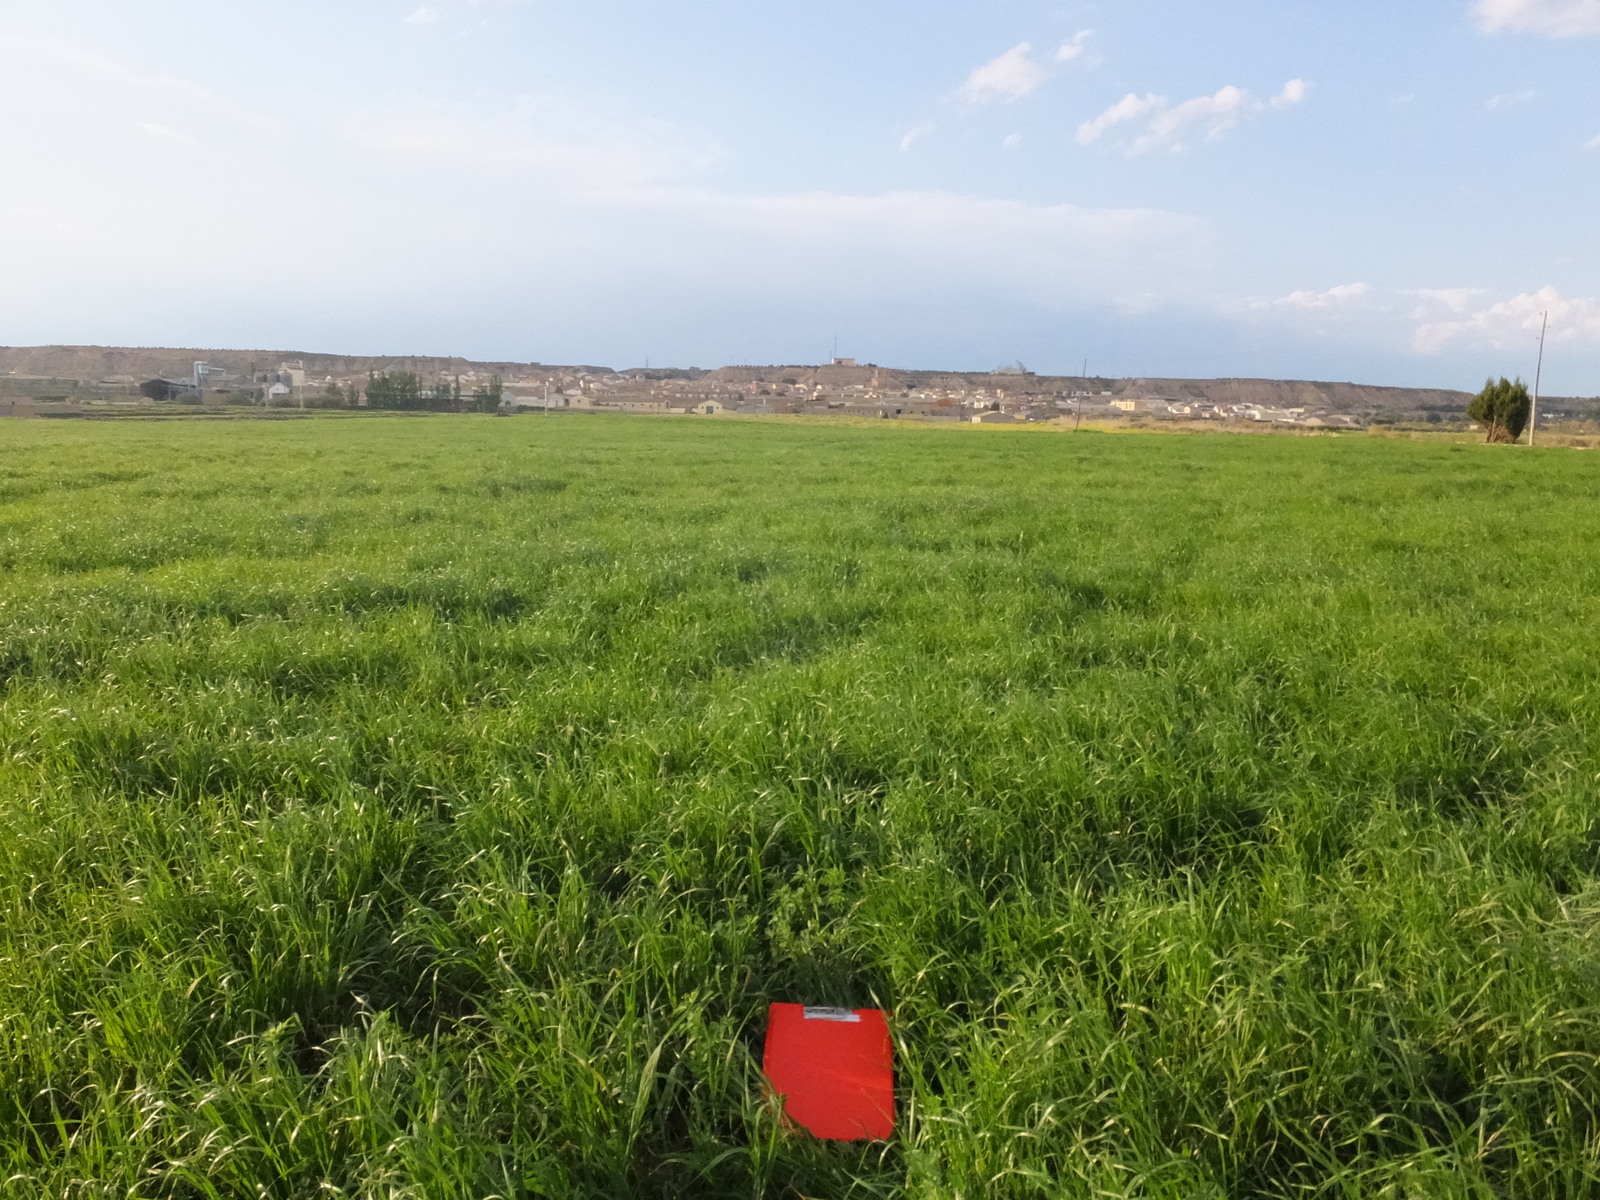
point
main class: Cropland
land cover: Other leguminous and mixtures for fodder
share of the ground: > 75 %
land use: Agriculture (excluding fallow land and kitchen gardens)
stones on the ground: < 10 %
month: April
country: ES
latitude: 41.7609
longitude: -0.3267
